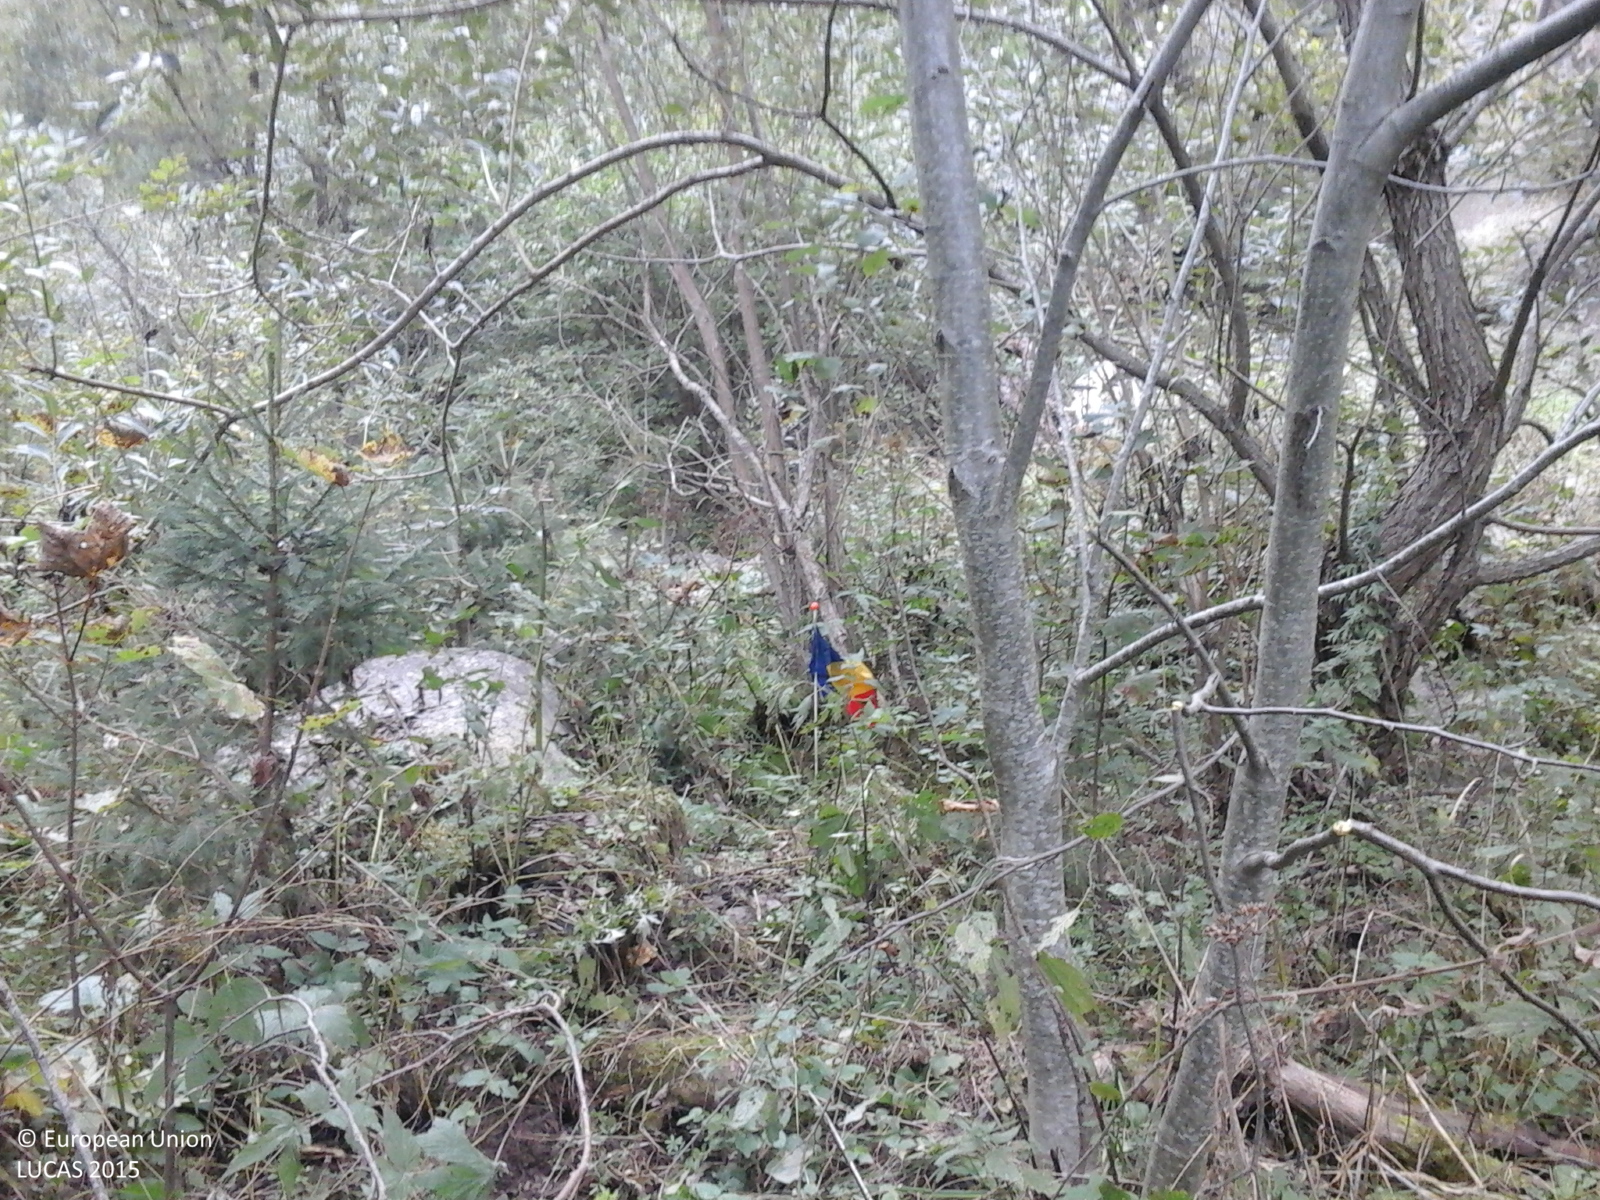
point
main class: Woodland
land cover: Broadleaved woodland
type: exotic forest
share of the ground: > 75 %
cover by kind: broadleaved forest trees 100 %
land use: Forestry
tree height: > 5 m
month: October
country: RO
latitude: 46.6279
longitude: 23.1628
